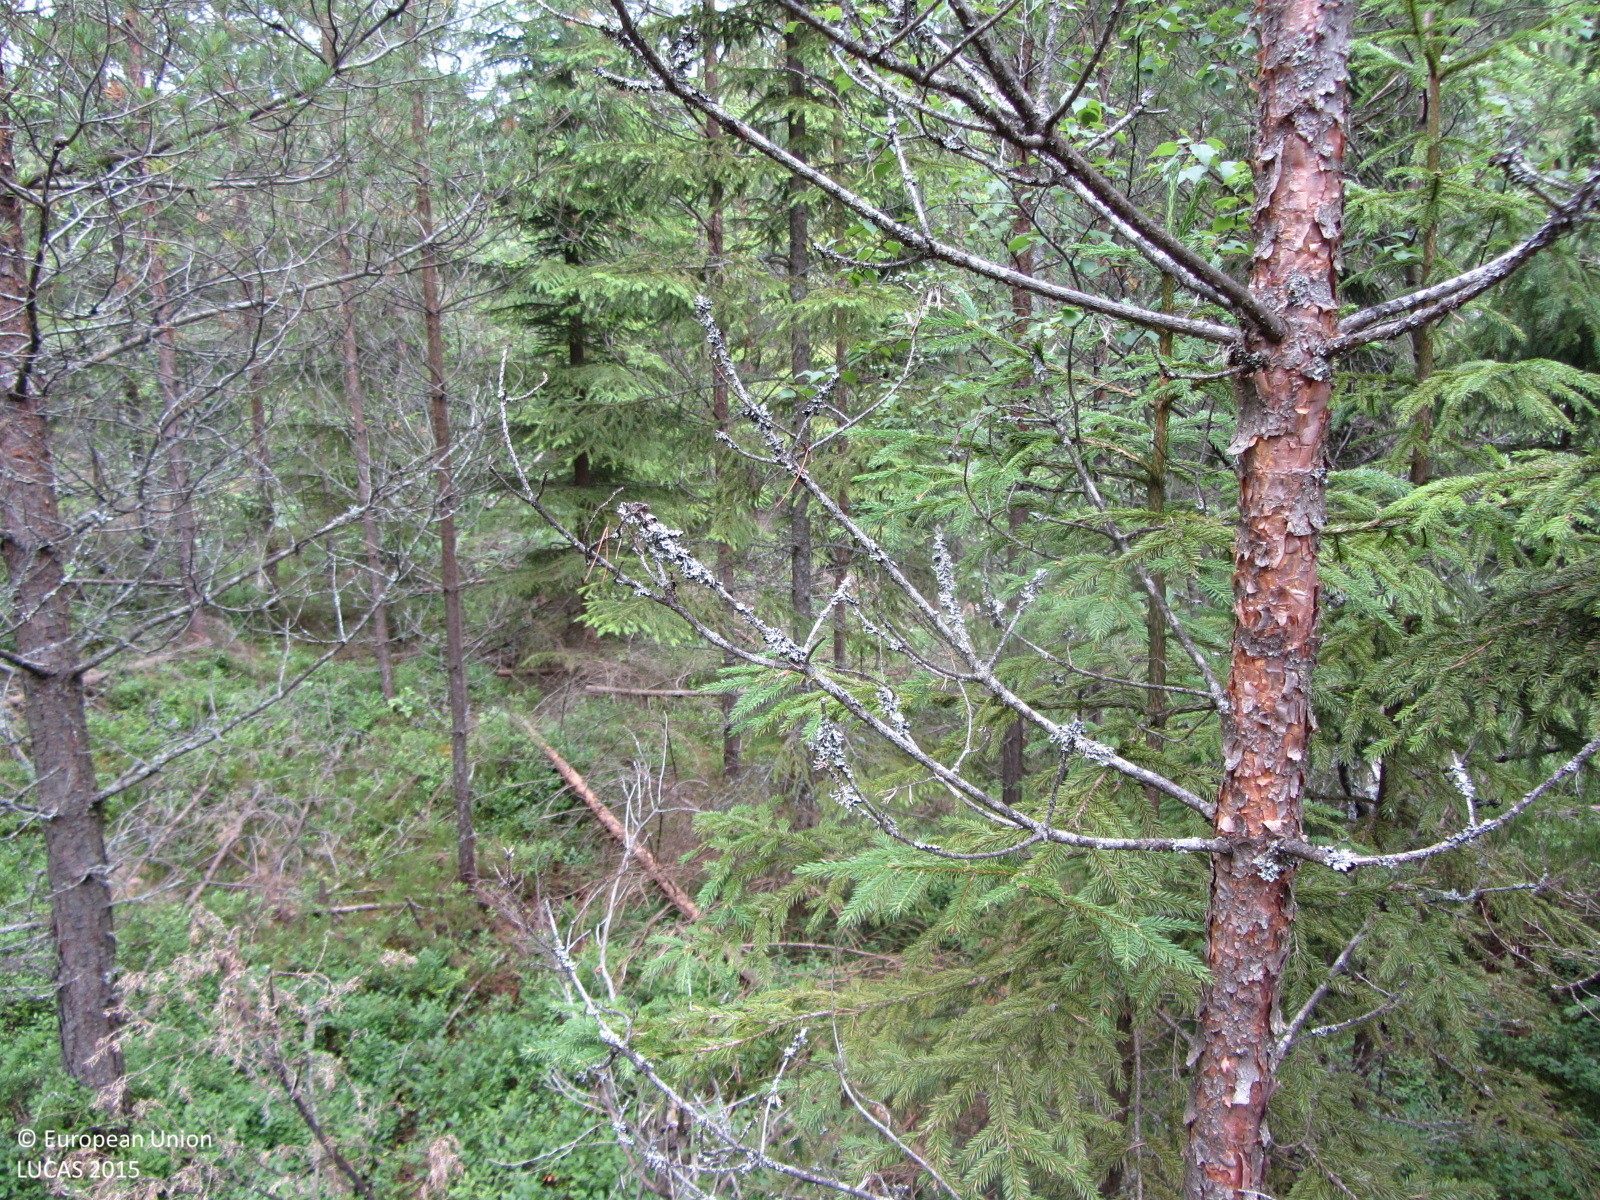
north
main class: Woodland
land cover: Other coniferous woodland
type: boreal forest
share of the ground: > 75 %
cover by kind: coniferous forest trees 80 %, shrubs 15 %, lichens and mosses 5 %
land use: Forestry
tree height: > 5 m
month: July
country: FI
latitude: 60.0232
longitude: 23.8587
